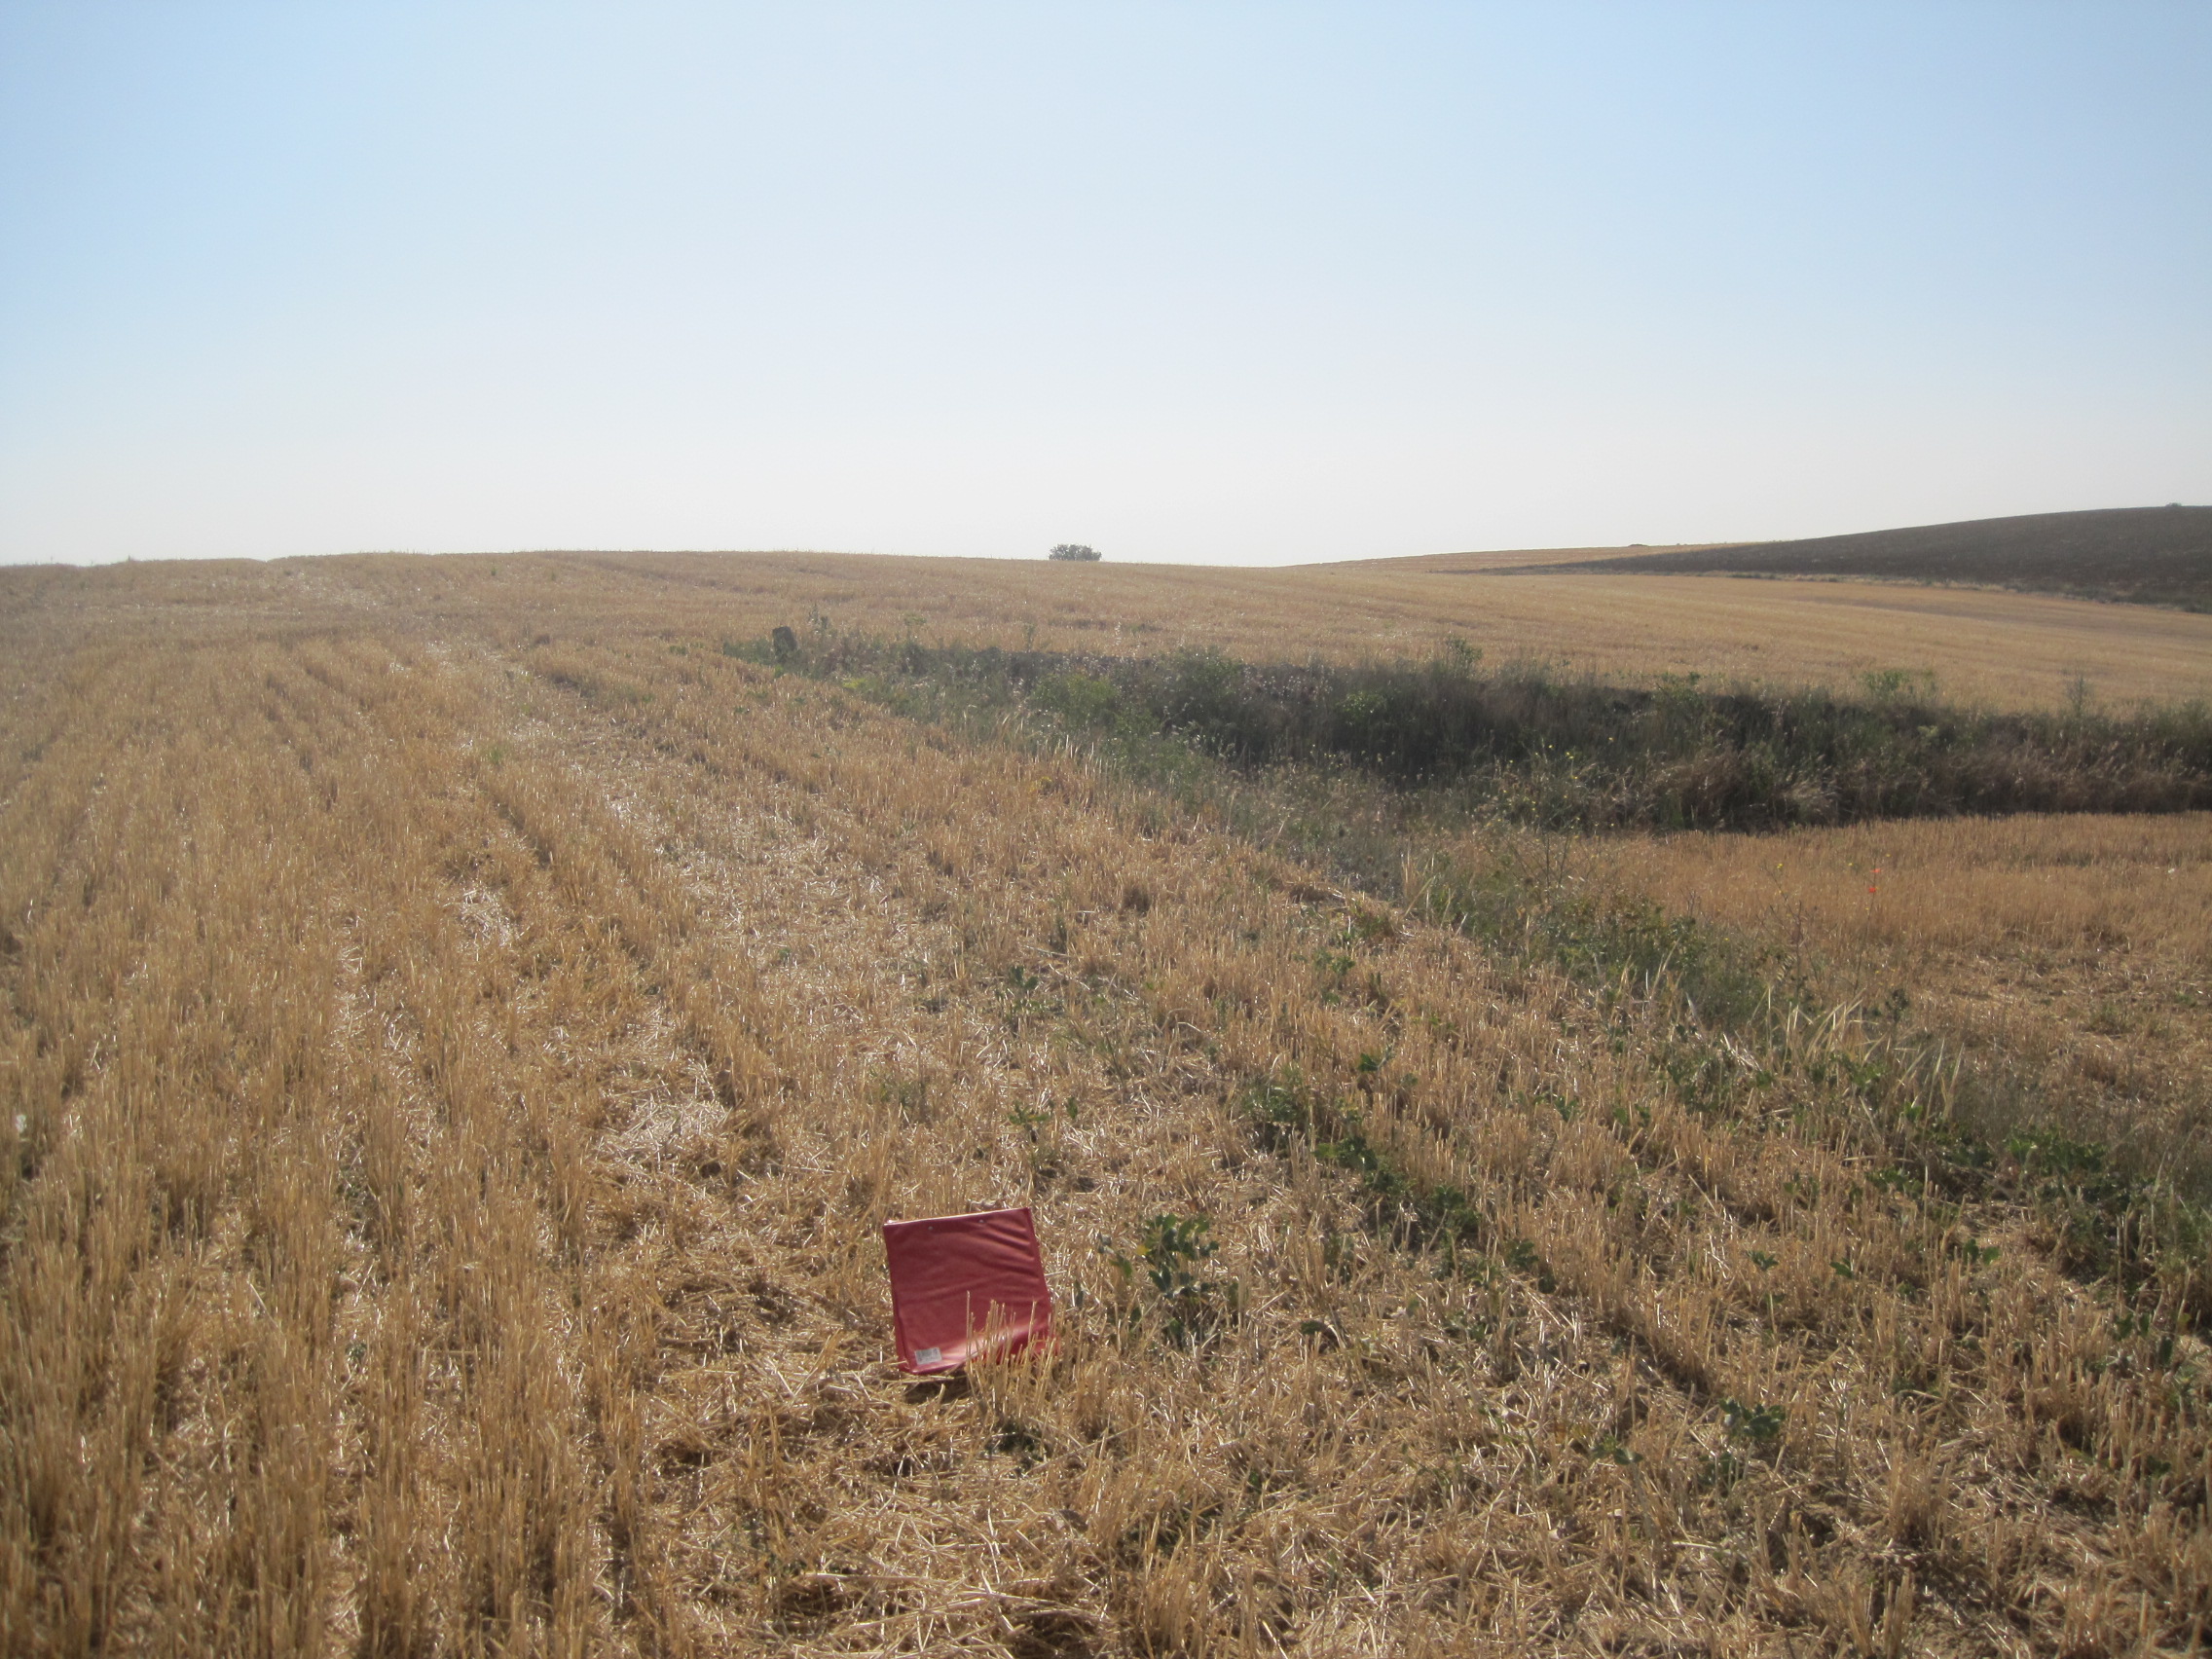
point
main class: Cropland
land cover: Barley
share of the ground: < 10 %
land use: Agriculture (excluding fallow land and kitchen gardens)
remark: Harvested field
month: July
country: ES
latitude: 41.6427
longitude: -5.3397
